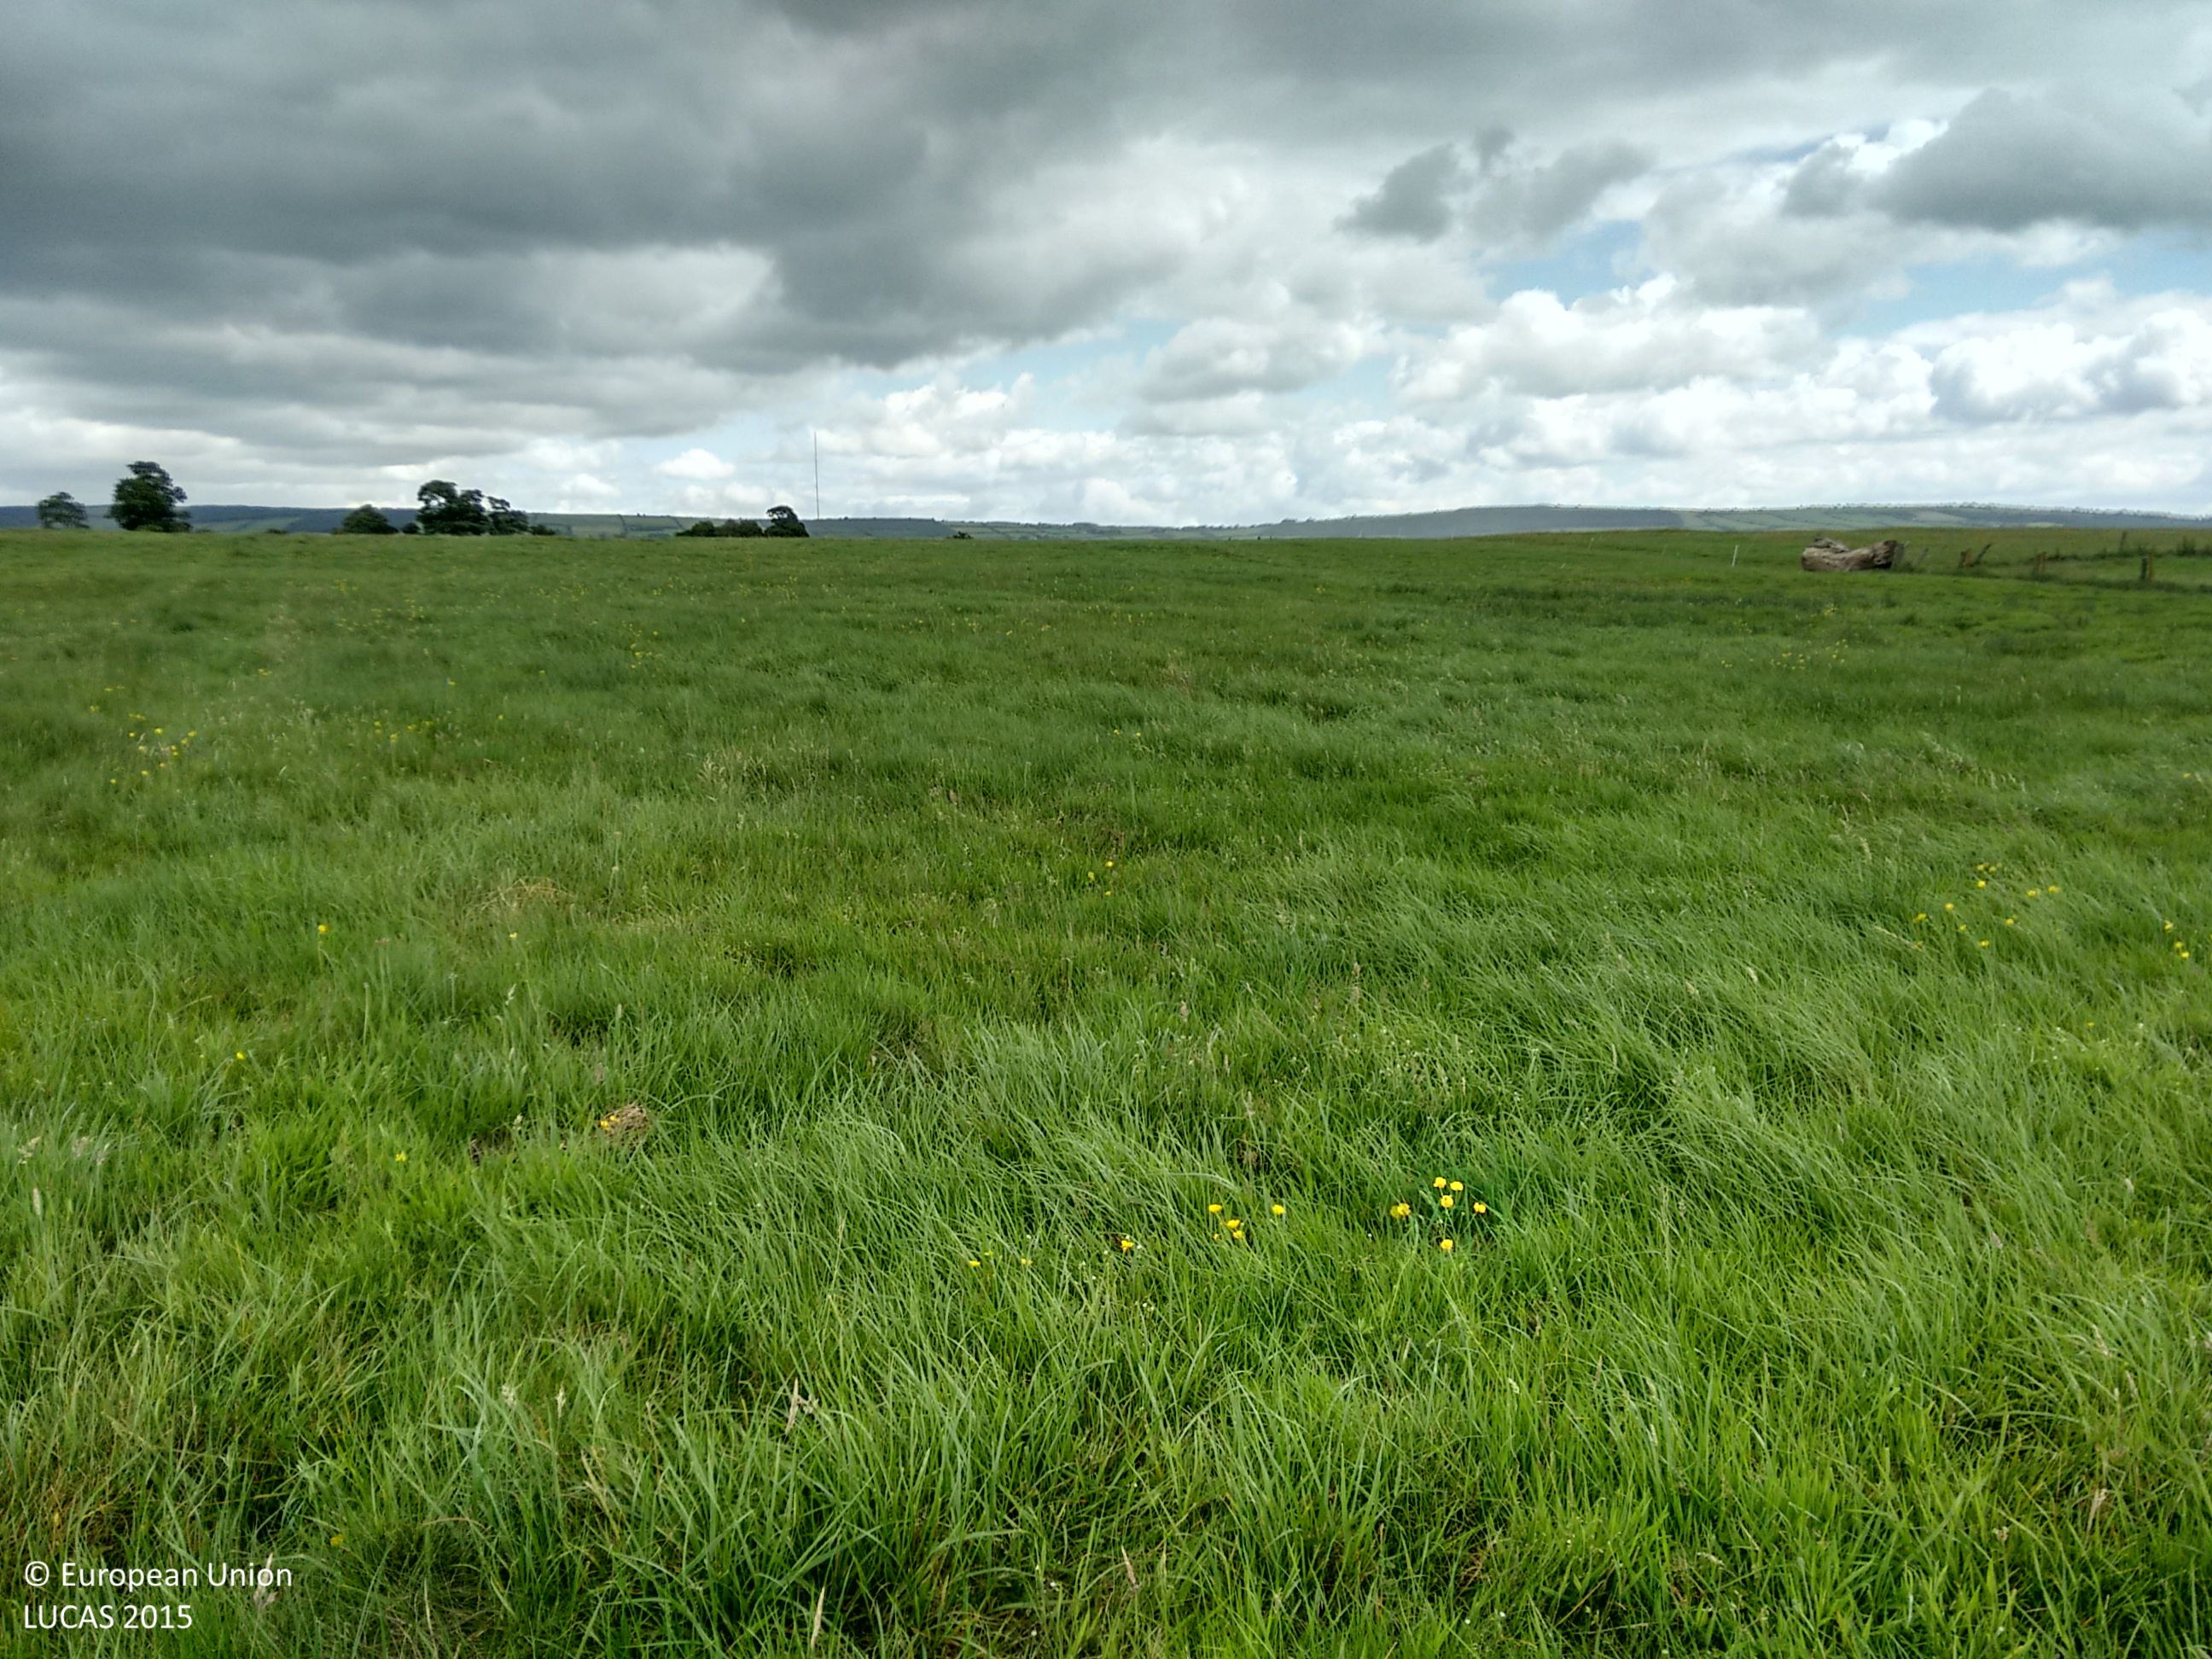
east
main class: Grassland
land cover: Grassland without tree/shrub cover
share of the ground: > 75 %
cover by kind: herbaceous plants 100 %
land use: Agriculture (excluding fallow land and kitchen gardens)
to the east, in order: Grassland without tree/shrub cover; Fences; Grassland without tree/shrub cover
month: July
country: IE
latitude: 52.7948
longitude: -7.3726
